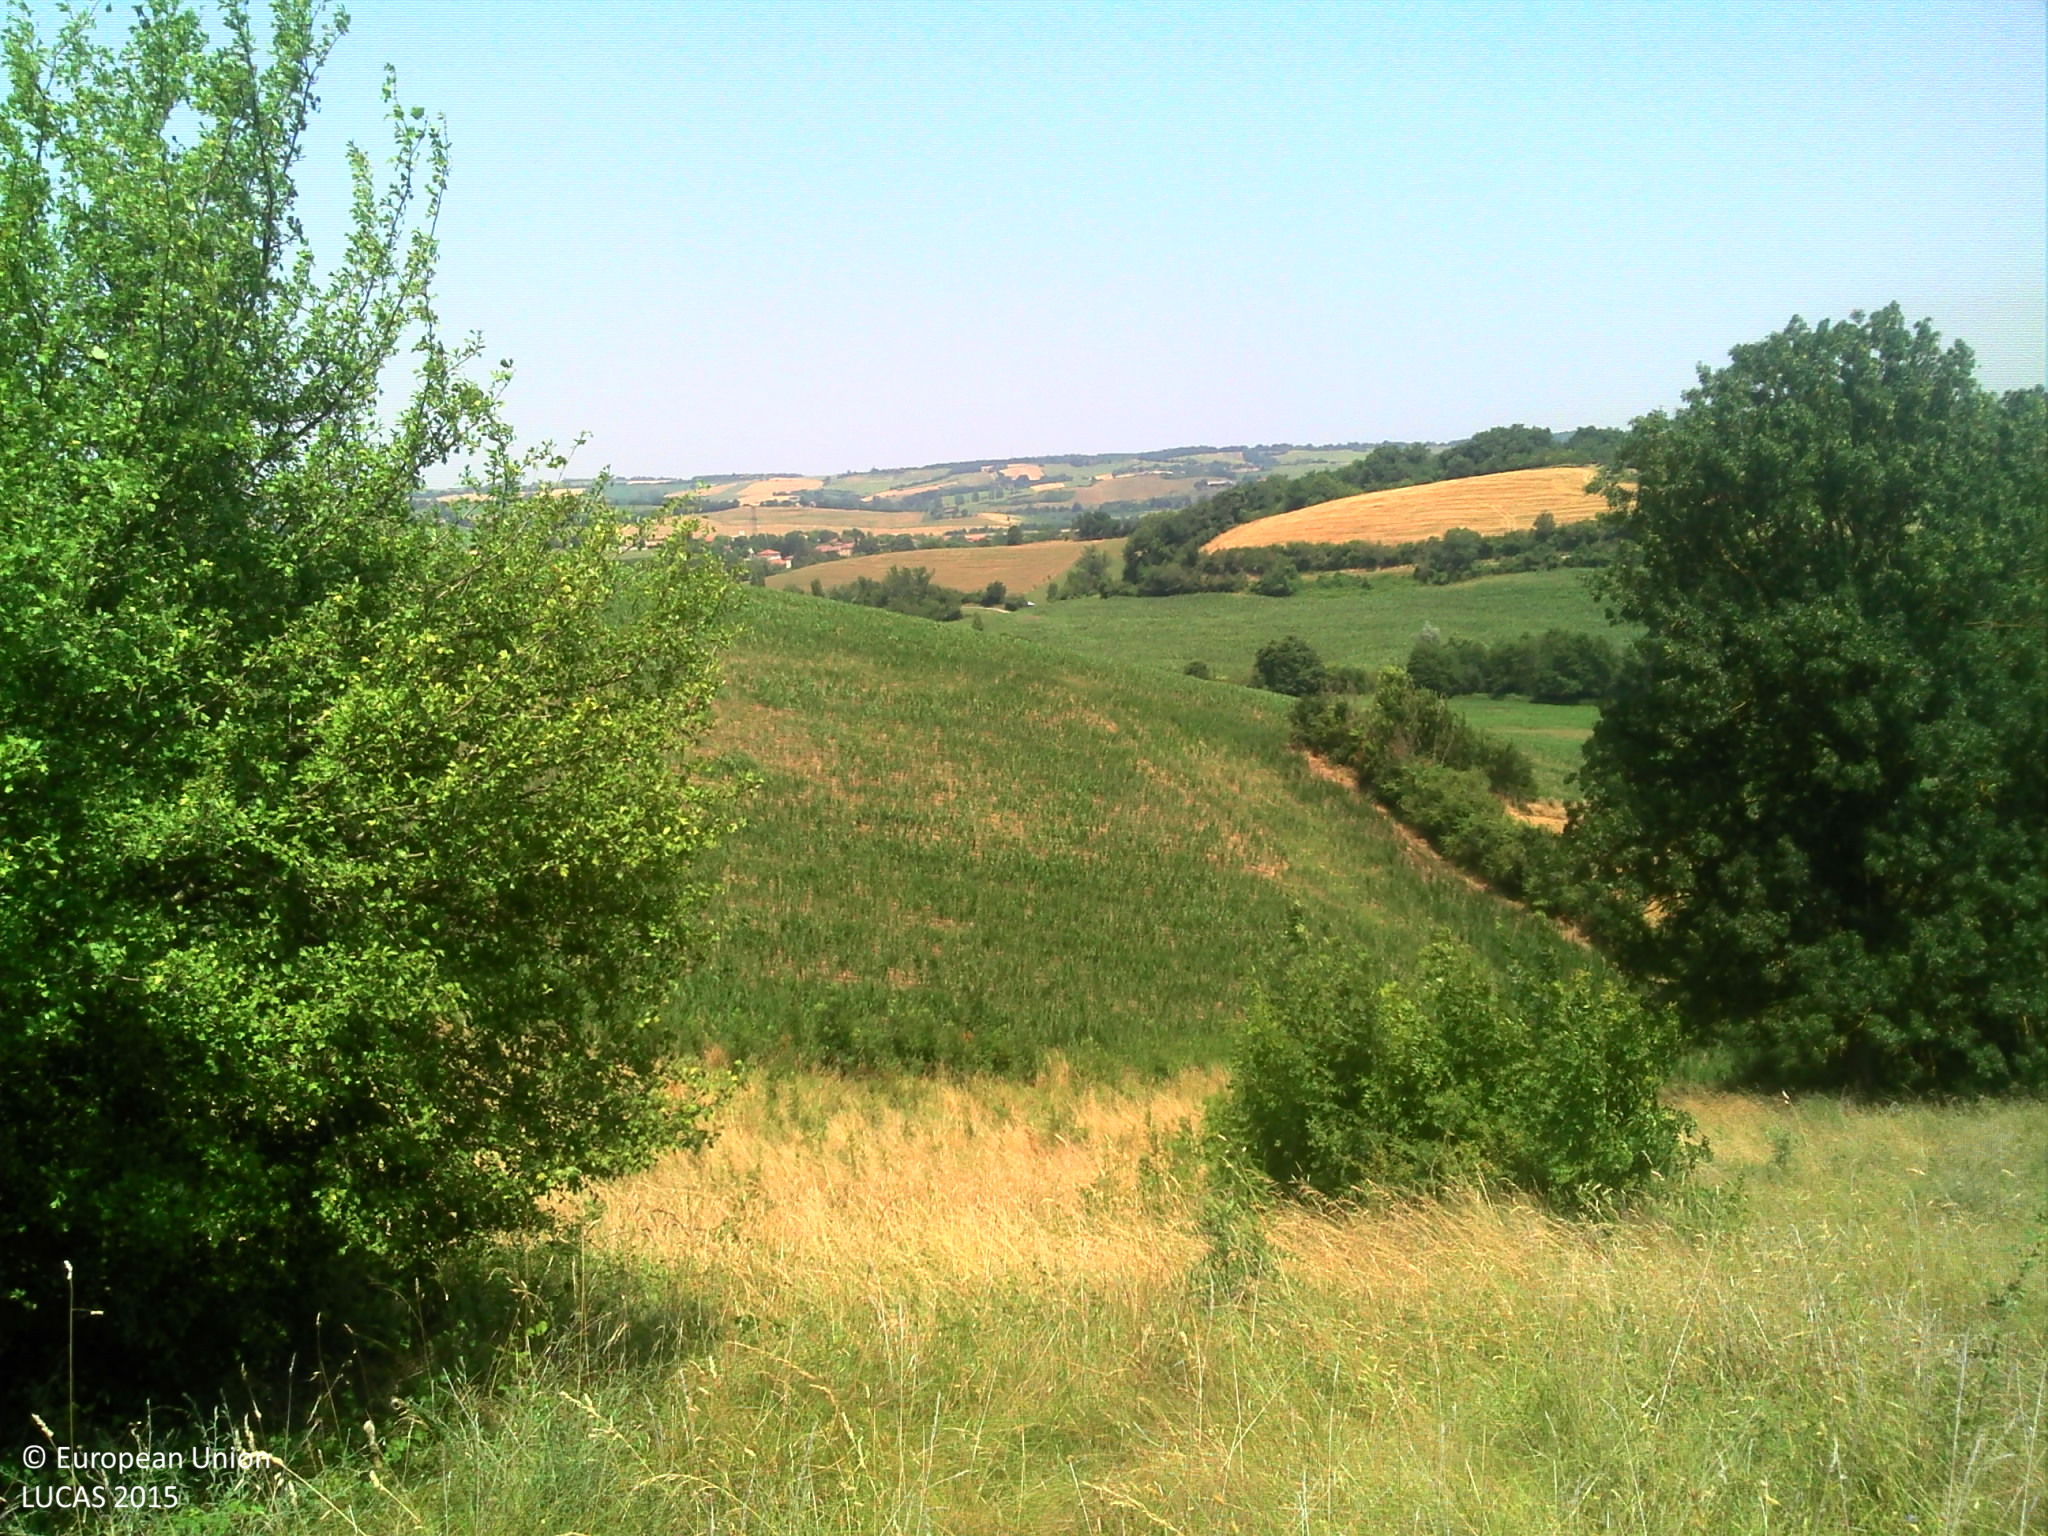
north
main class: Grassland
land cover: Grassland with sparse tree/shrub cover
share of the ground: > 75 %
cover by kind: herbaceous plants 95 %, broadleaved forest trees 5 %
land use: Agriculture (excluding fallow land and kitchen gardens)
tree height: < 5 m
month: July
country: FR
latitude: 43.3270
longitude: 1.0366
